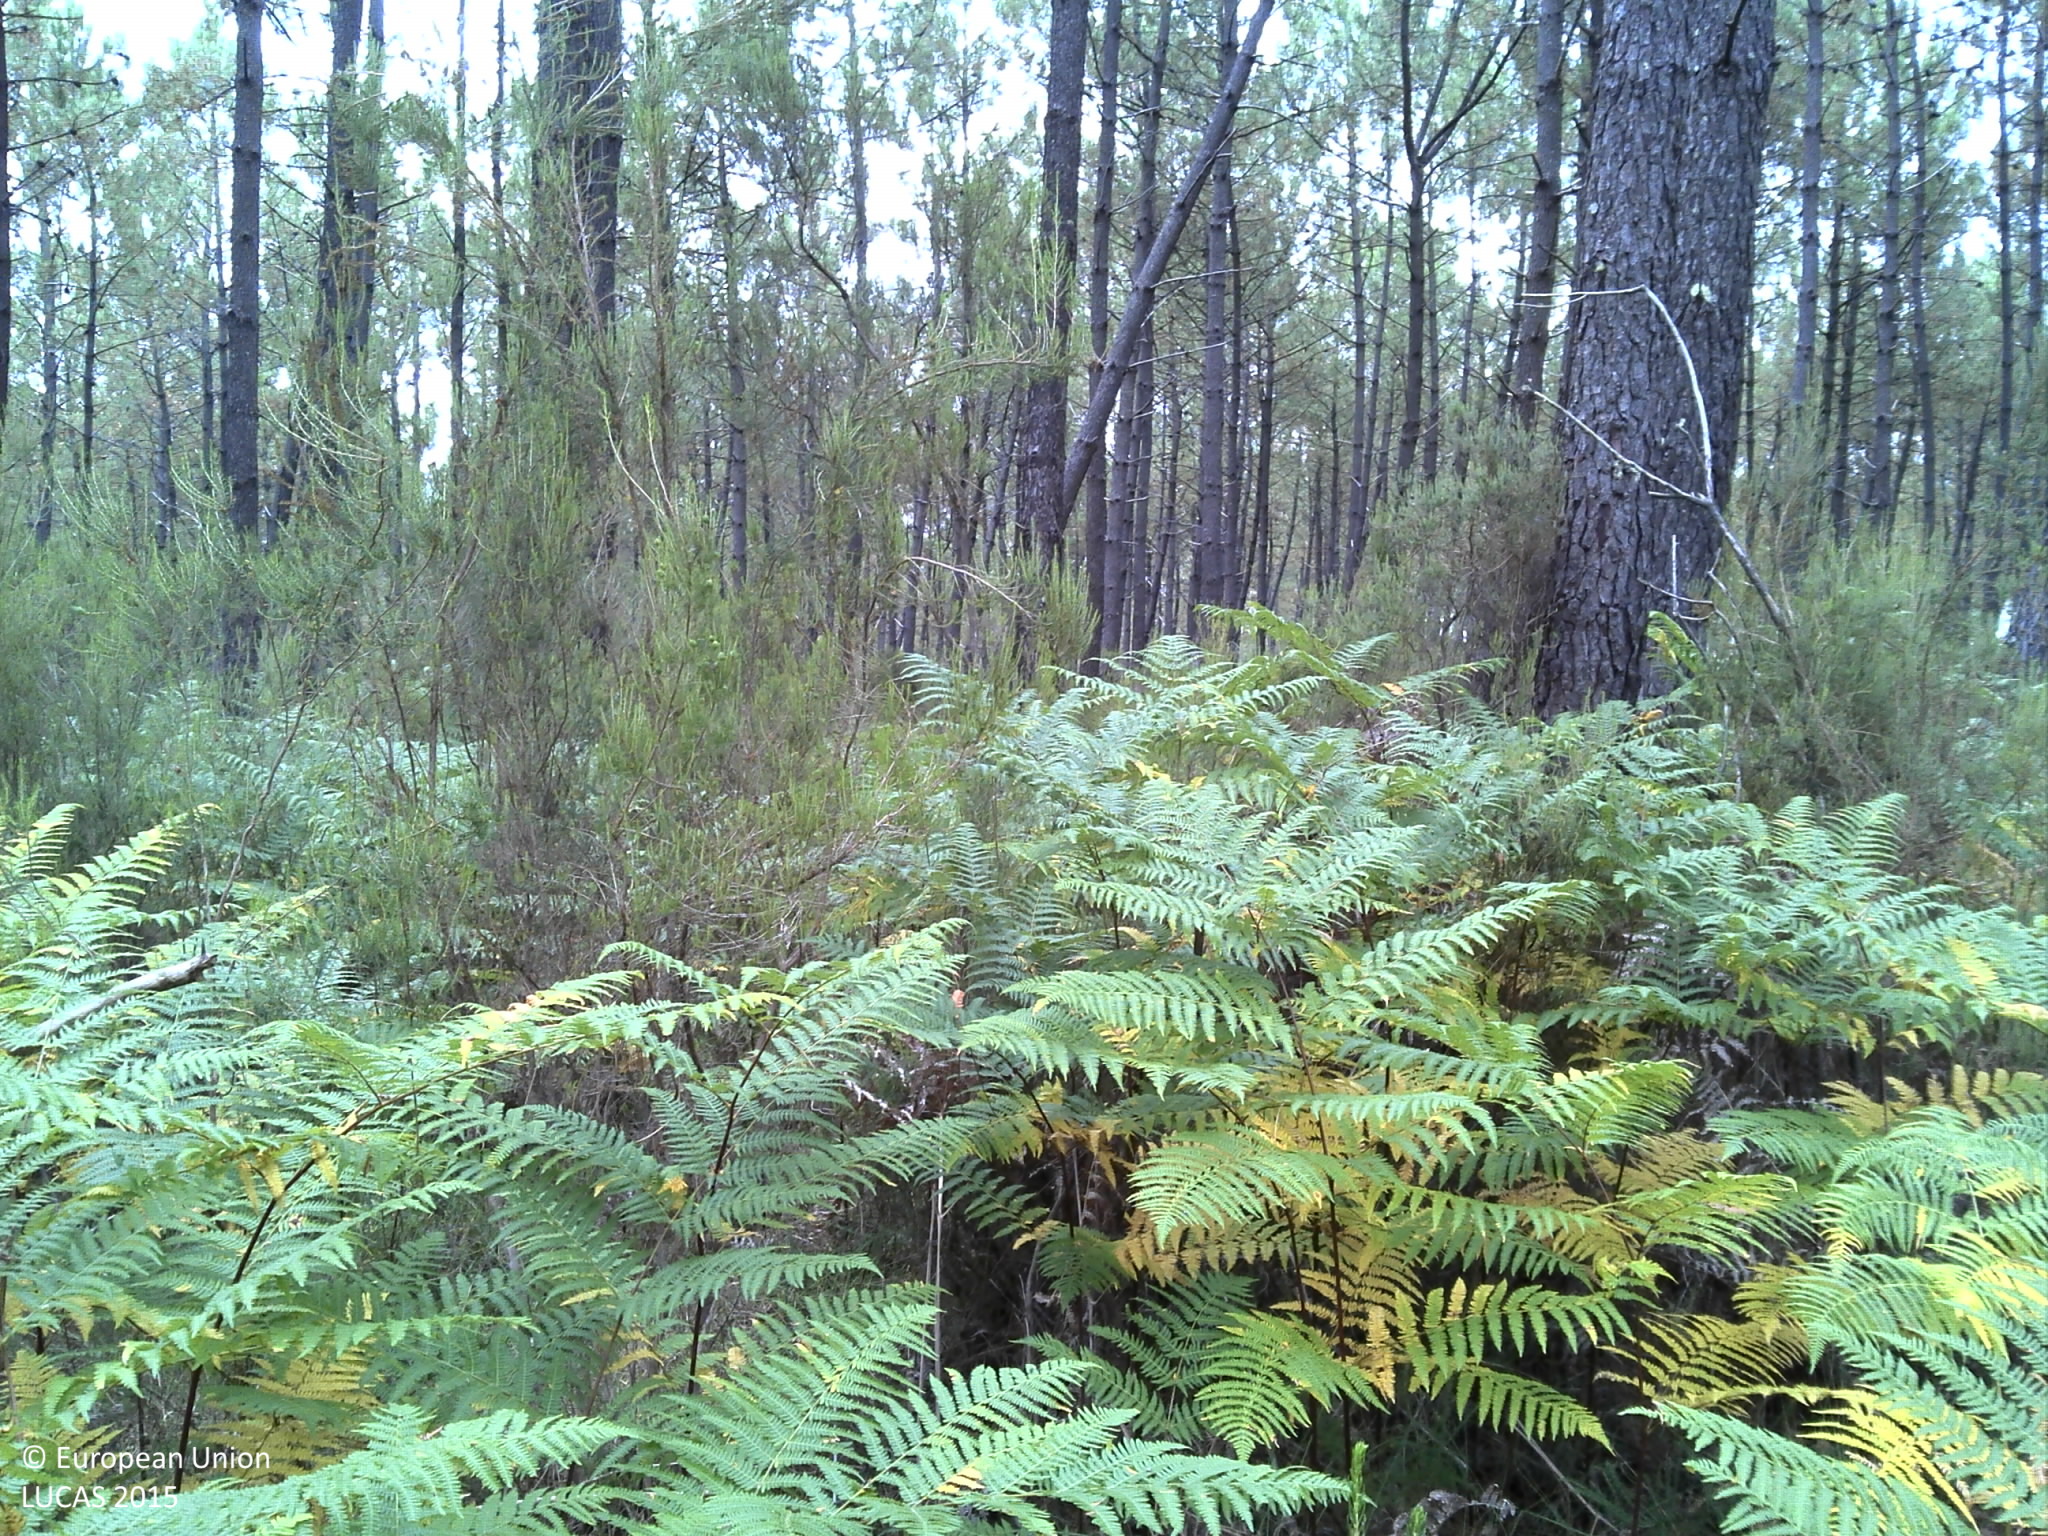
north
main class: Woodland
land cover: Pine dominated coniferous woodland
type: coniferous forest of the mediterranean region
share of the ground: > 75 %
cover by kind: shrubs 50 %, coniferous forest trees 40 %, lichens and mosses 10 %
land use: Forestry
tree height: > 5 m
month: July
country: FR
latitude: 45.0898
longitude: -1.0148
